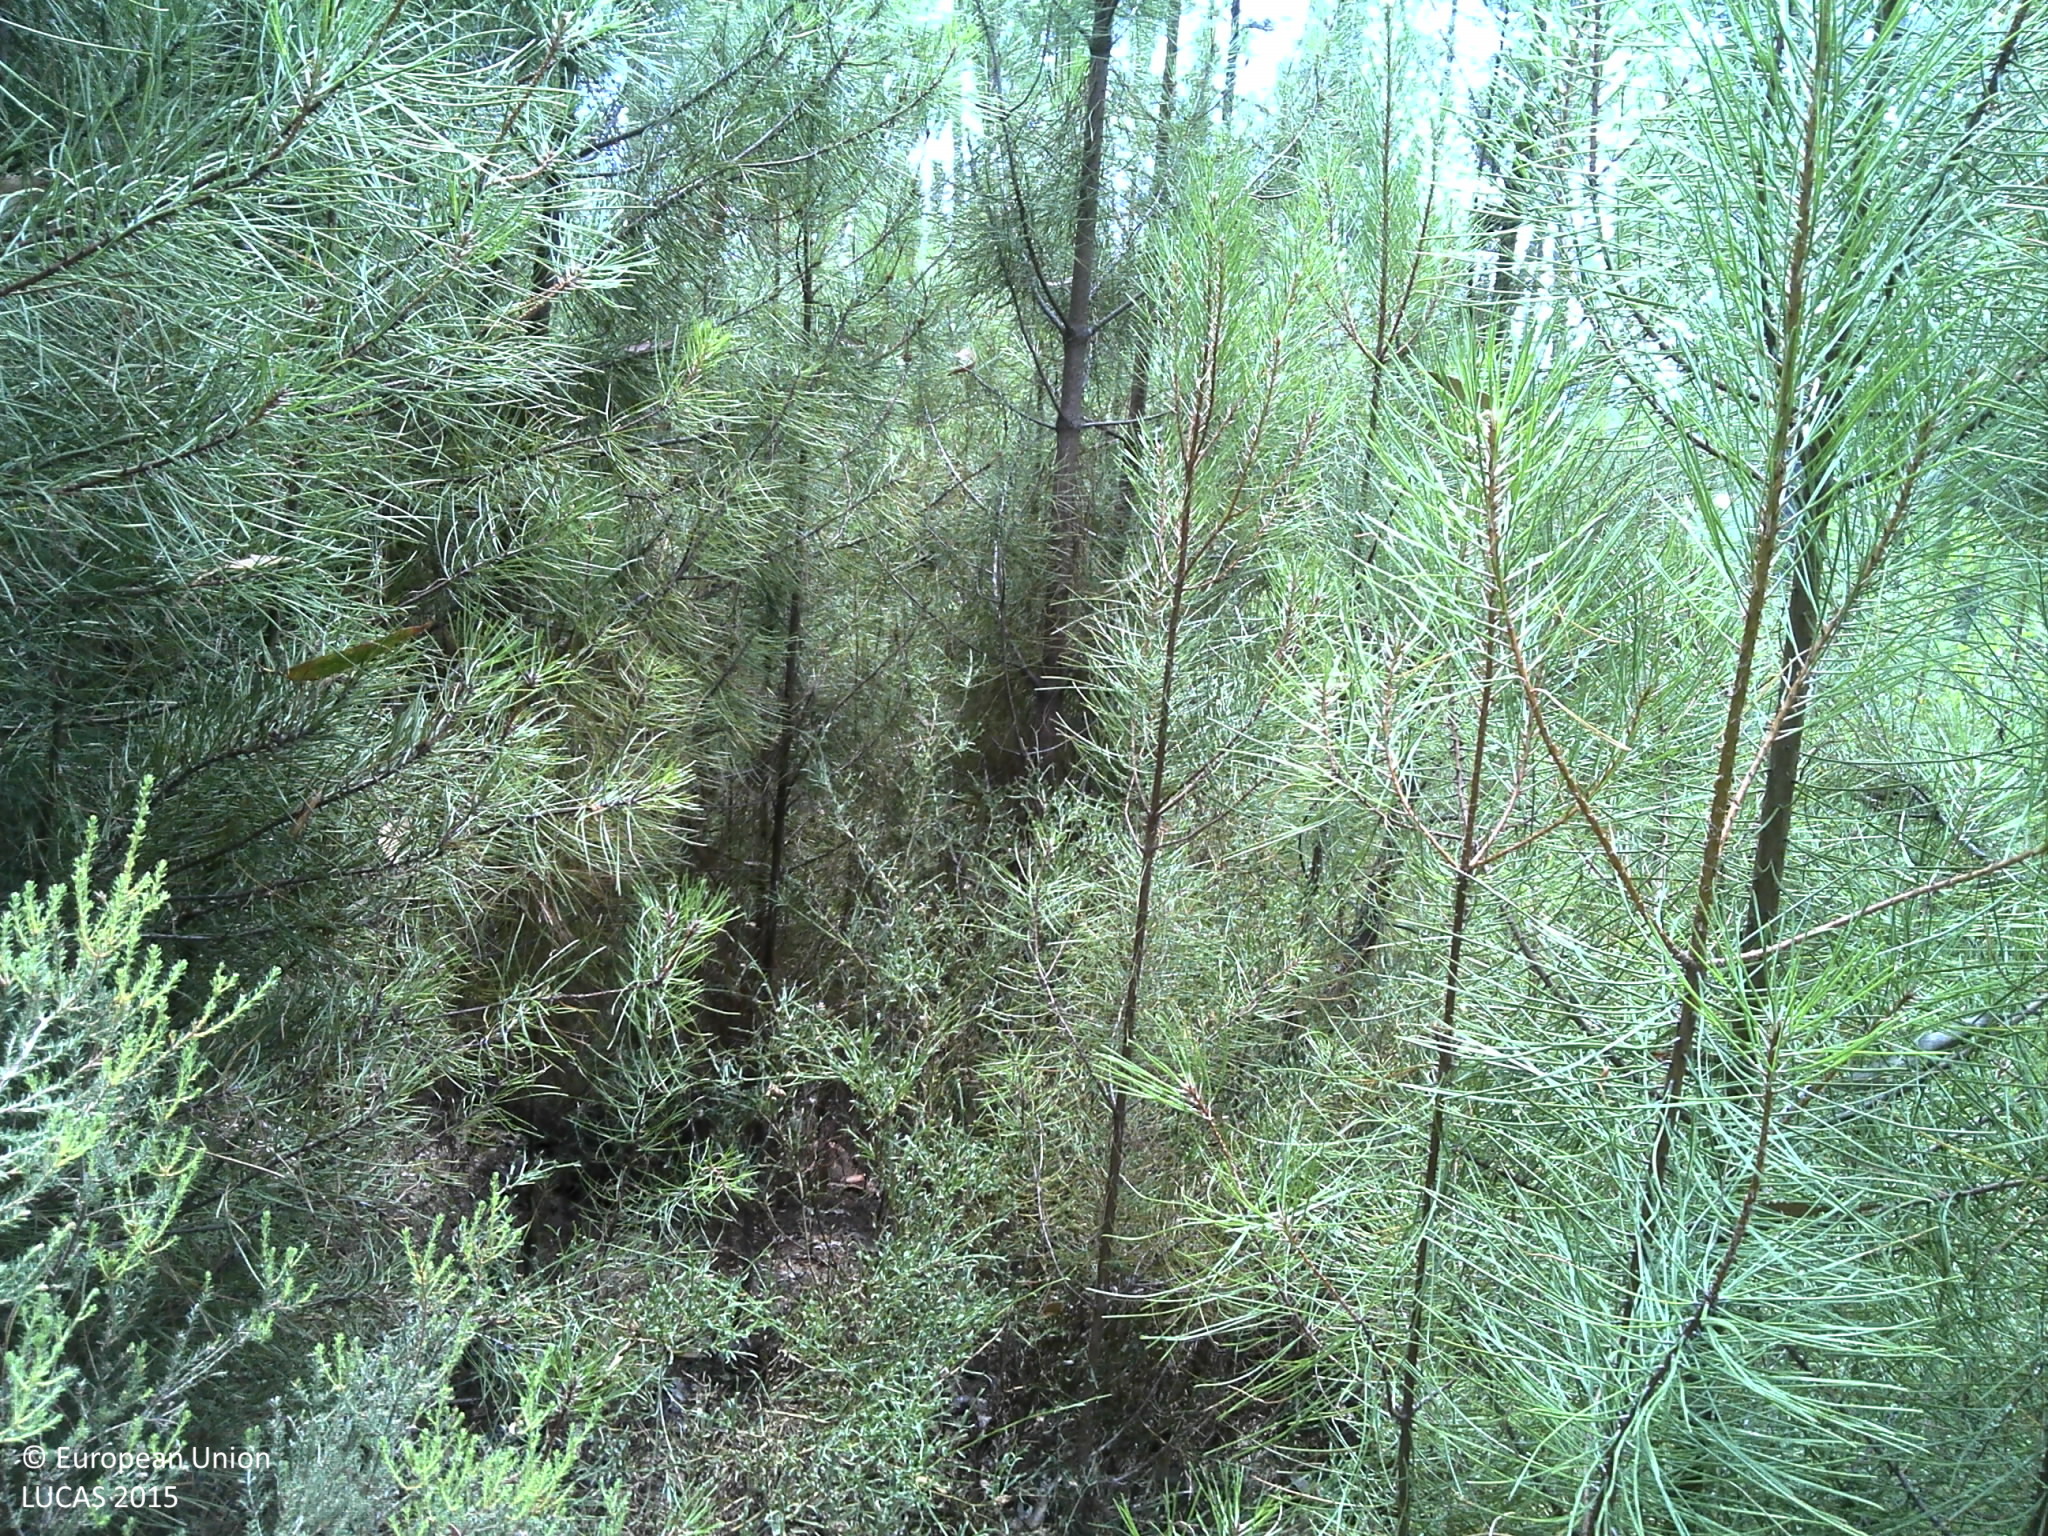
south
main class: Woodland
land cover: Pine dominated mixed woodland
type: coniferous forest of the mediterranean region
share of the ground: 50 - 75 %
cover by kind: coniferous forest trees 30 %, shrubs 30 %, broadleaved forest trees 20 %, unconsolidated bare surface 10 %, consolidated bare surface 5 %
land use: Forestry
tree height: > 5 m
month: July
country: PT
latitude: 39.8912
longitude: -8.0422
